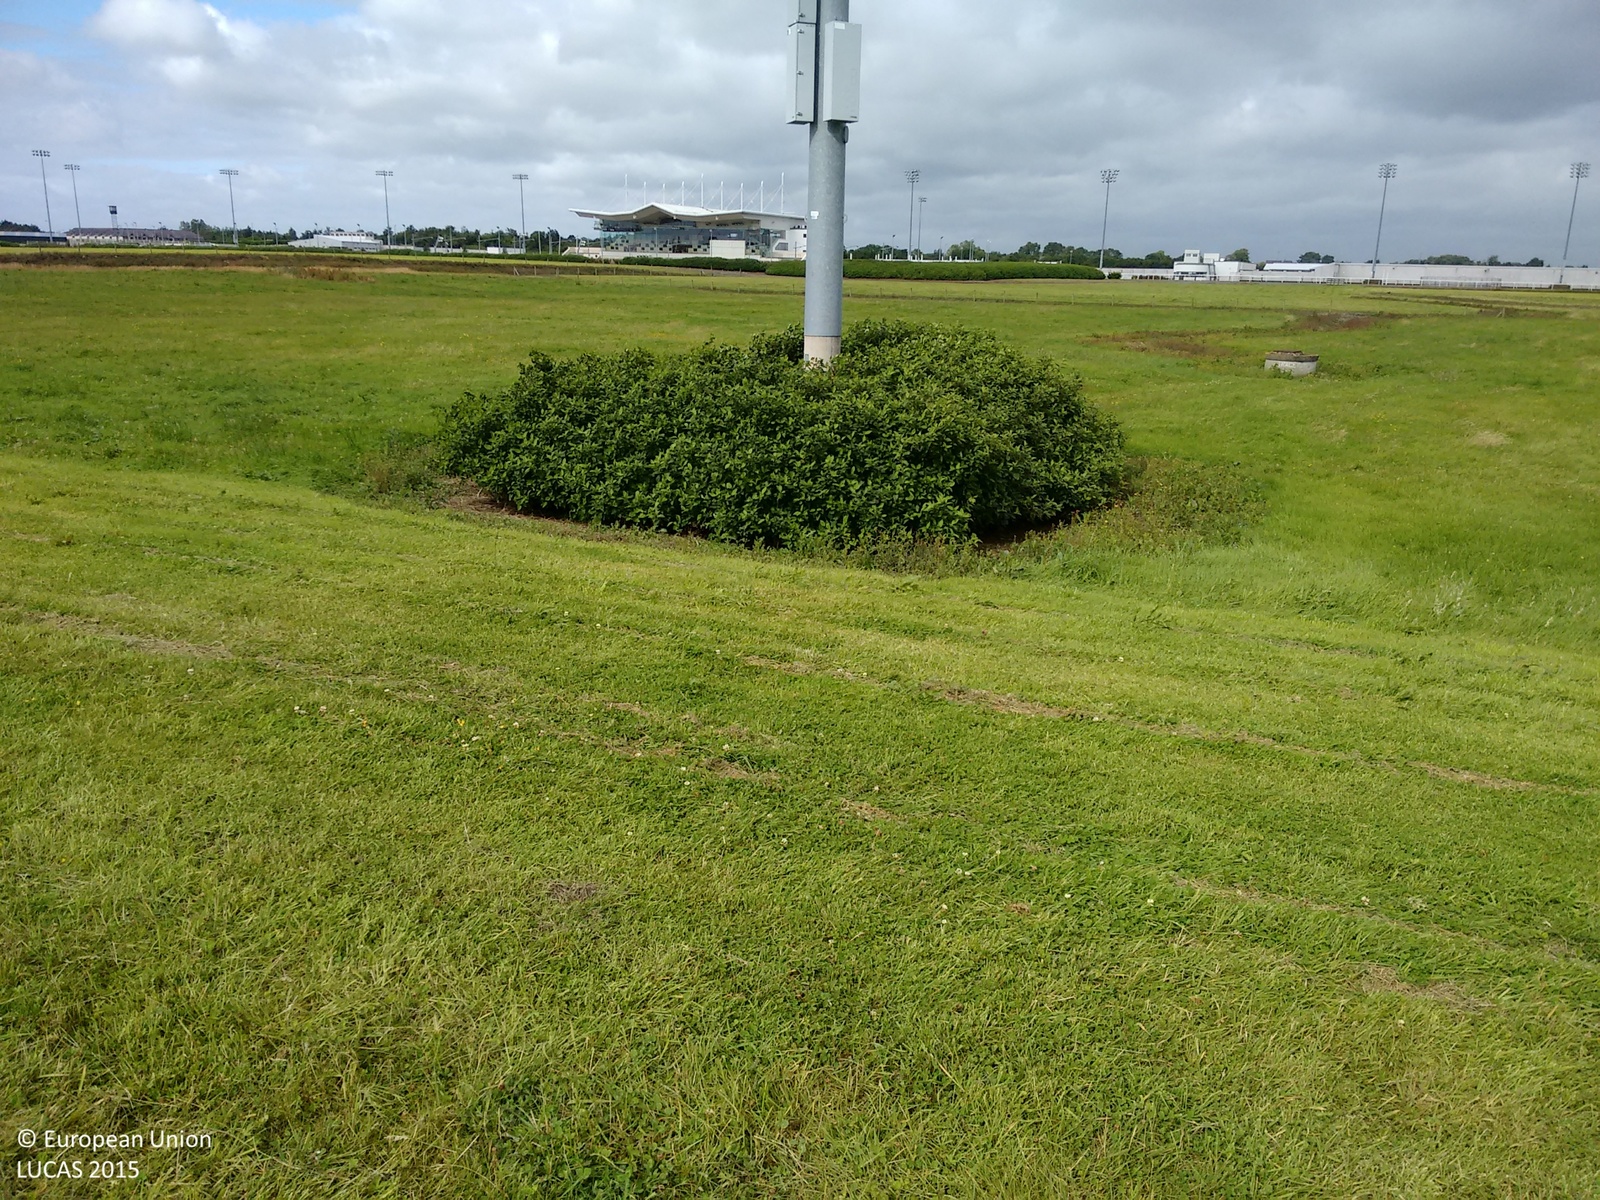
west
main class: Grassland
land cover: Grassland without tree/shrub cover
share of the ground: > 75 %
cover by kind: herbaceous plants 100 %
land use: Amenities, museums, leisure
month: August
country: IE
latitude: 54.0213
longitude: -6.3776
